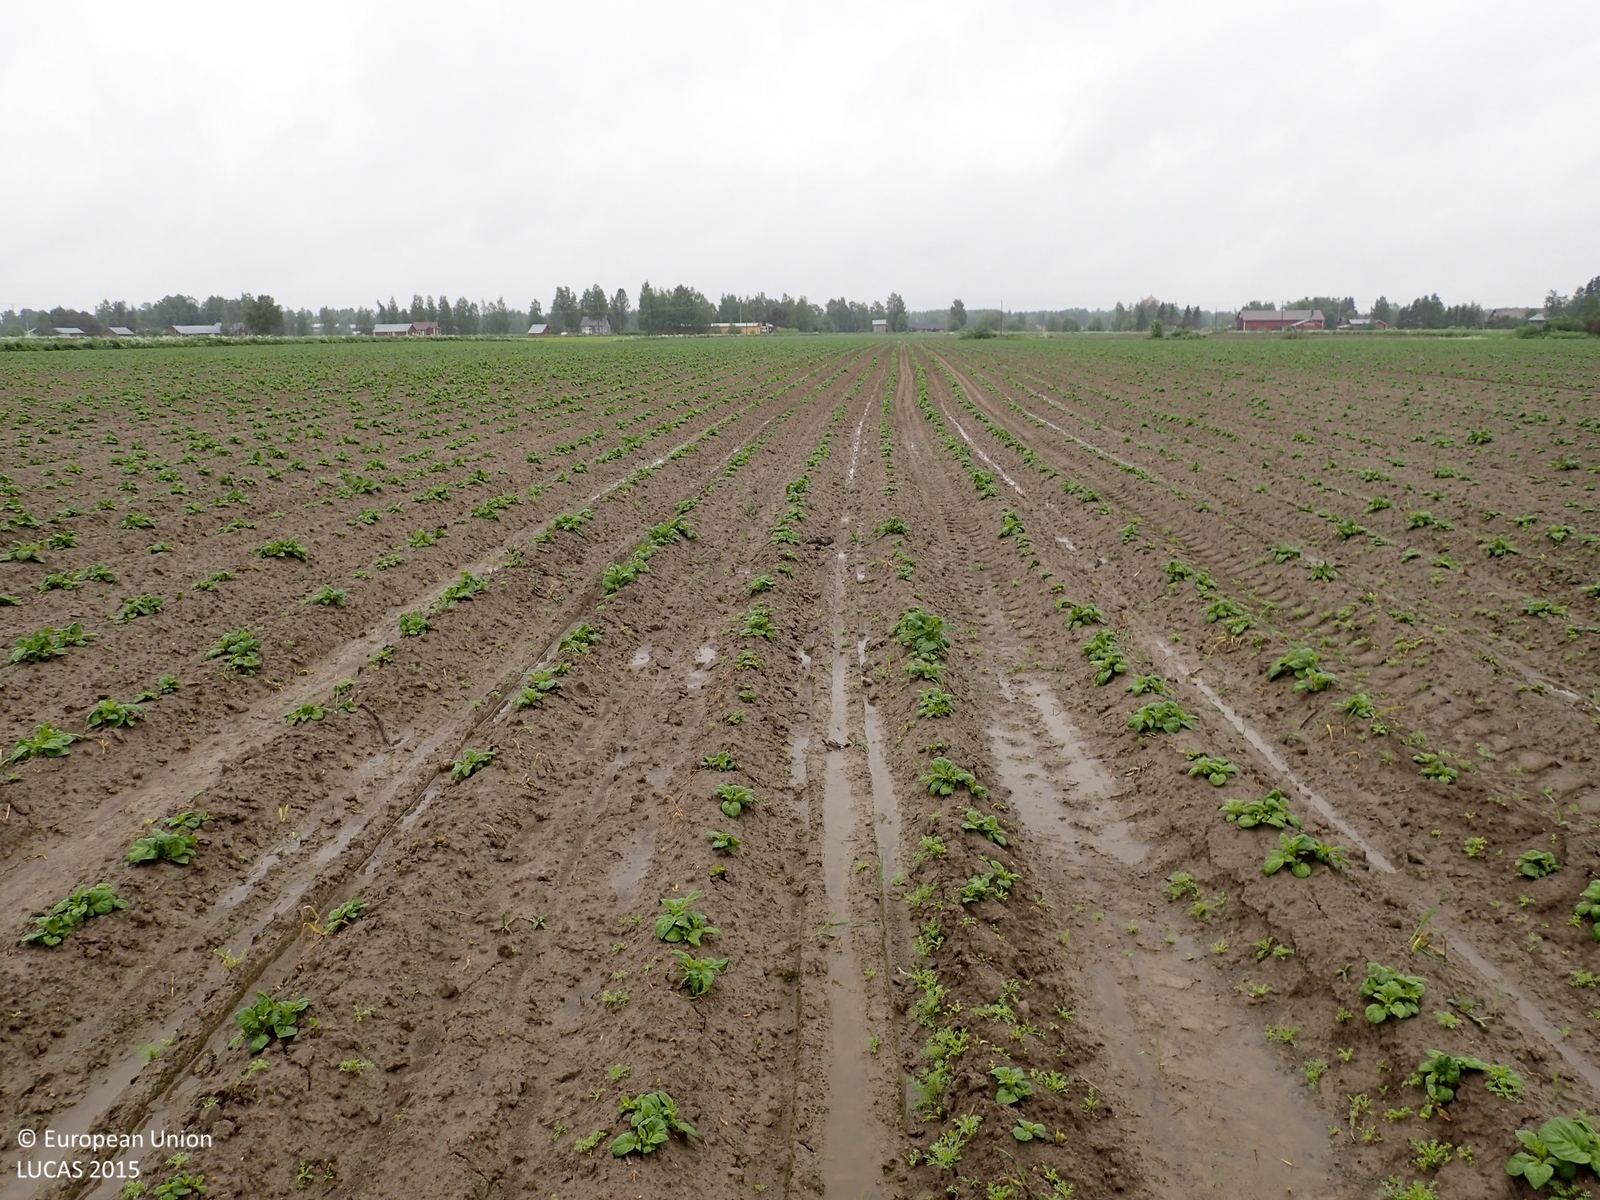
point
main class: Cropland
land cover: Potatoes
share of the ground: 10 - 25 %
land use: Agriculture (excluding fallow land and kitchen gardens)
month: June
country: FI
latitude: 62.2583
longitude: 21.5420
